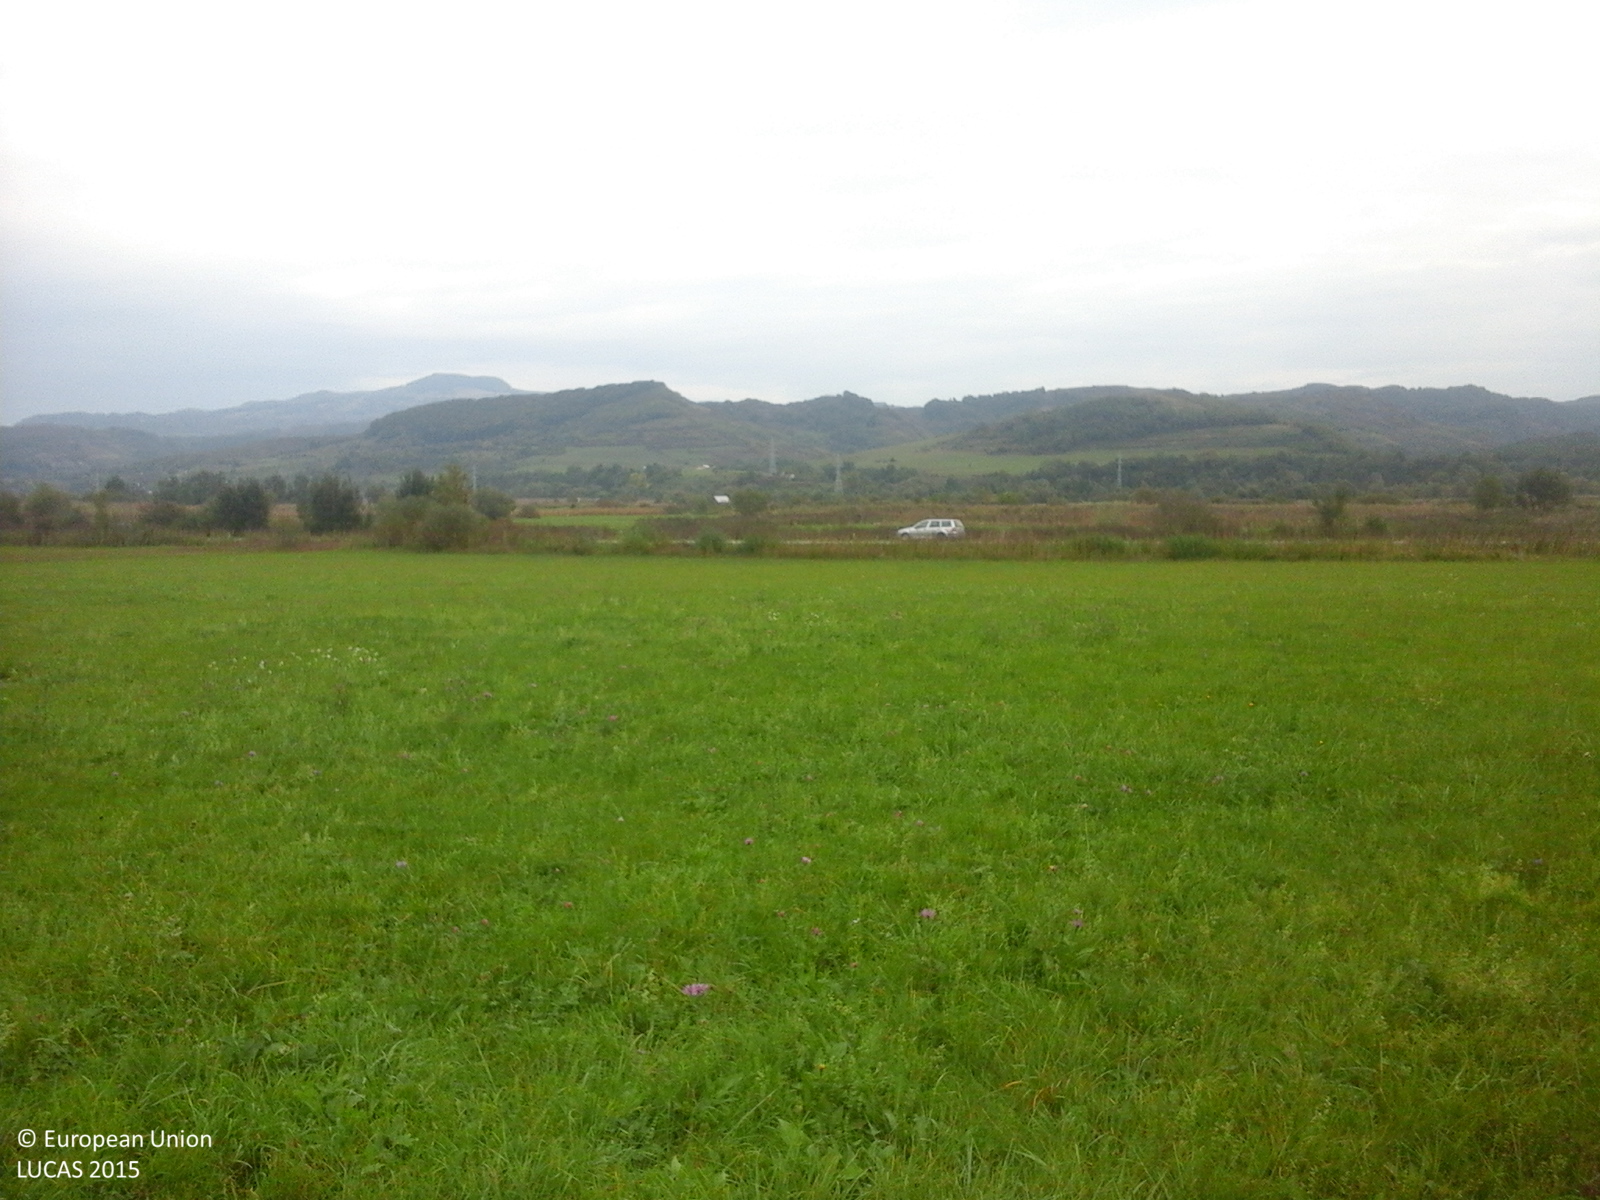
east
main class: Grassland
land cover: Grassland without tree/shrub cover
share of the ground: > 75 %
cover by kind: herbaceous plants 100 %
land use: Agriculture (excluding fallow land and kitchen gardens)
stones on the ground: < 10 %
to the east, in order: Grassland without tree/shrub cover; Abandoned hedges; Ditches and canals; Paved roads, cycling and walking lanes; Grass margins; Ditches and canals; Abandoned hedges; Ditches and canals; Spontaneously vegetated surfaces; Ditches and canals; Grassland without tree/shrub cover; Ditches and canals; Grassland without tree/shrub cover
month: October
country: RO
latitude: 46.5205
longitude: 24.9433
